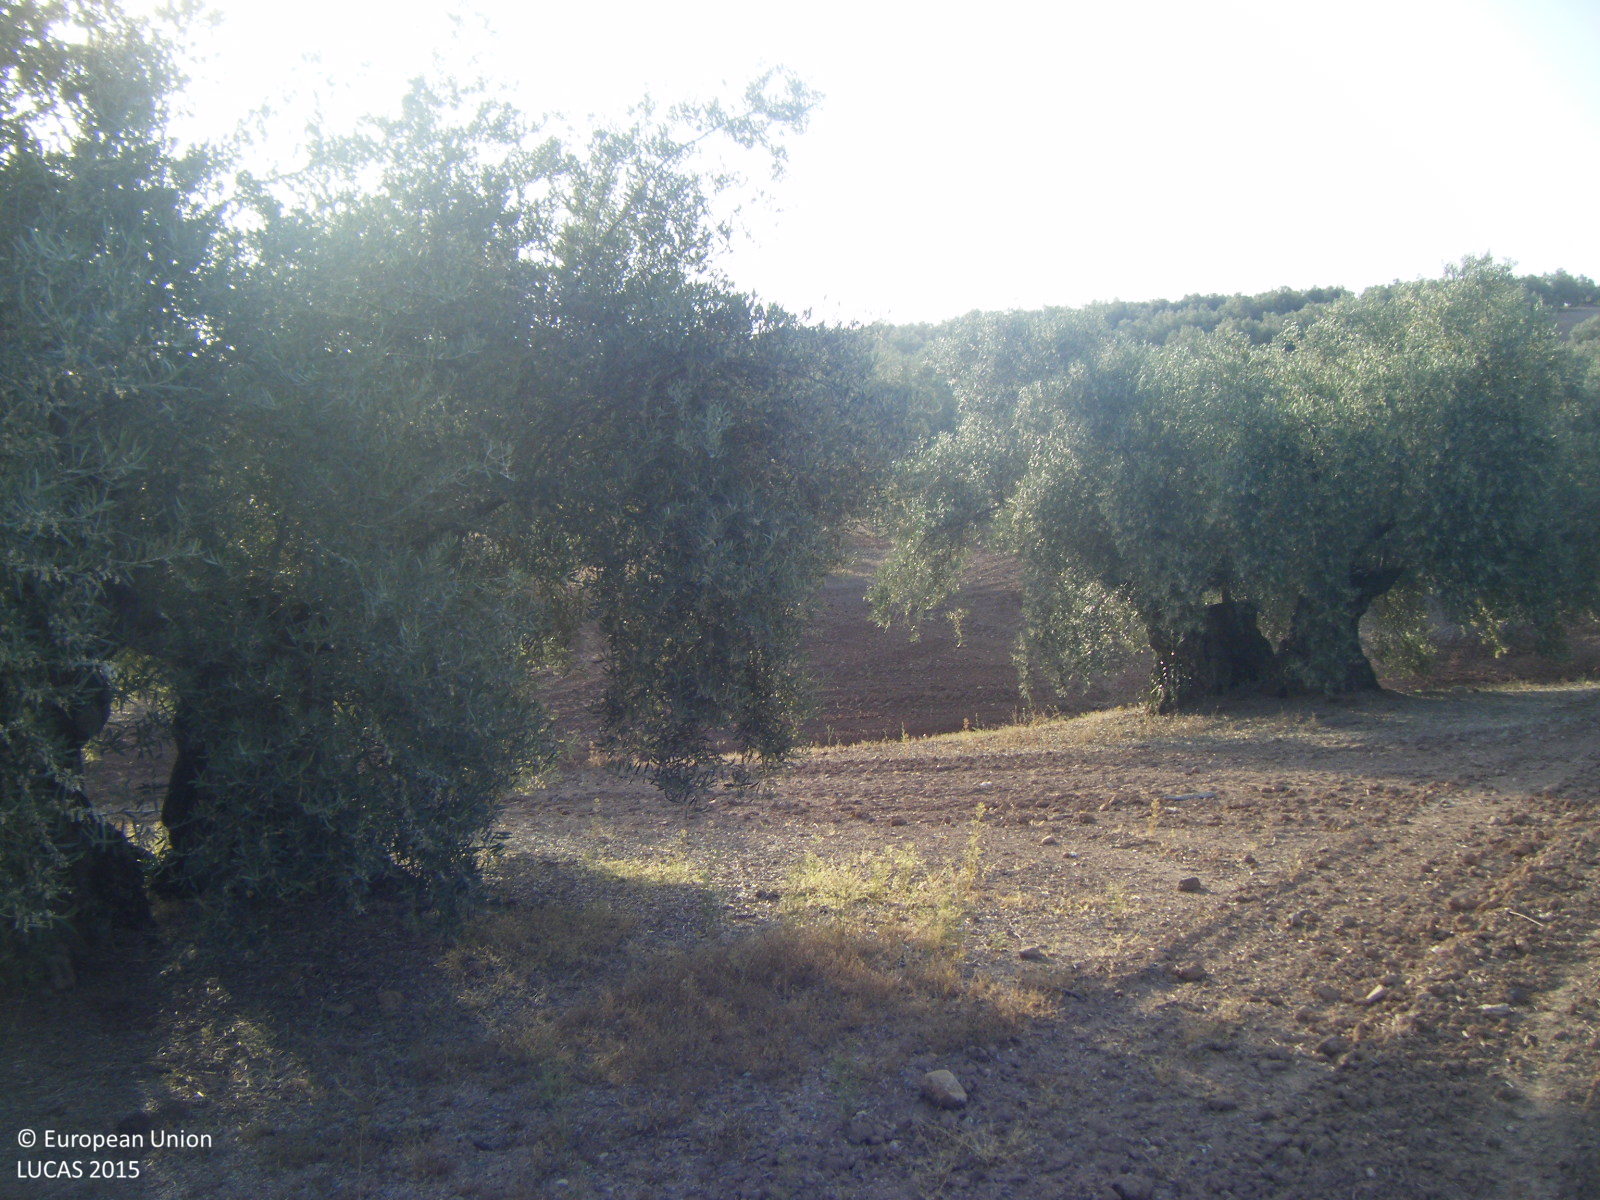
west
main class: Cropland
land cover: Olive groves
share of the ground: 25 - 50 %
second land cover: Other bare soil
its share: > 75 %
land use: Agriculture (excluding fallow land and kitchen gardens)
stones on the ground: < 10 %
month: May
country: ES
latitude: 37.3034
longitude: -4.5440
